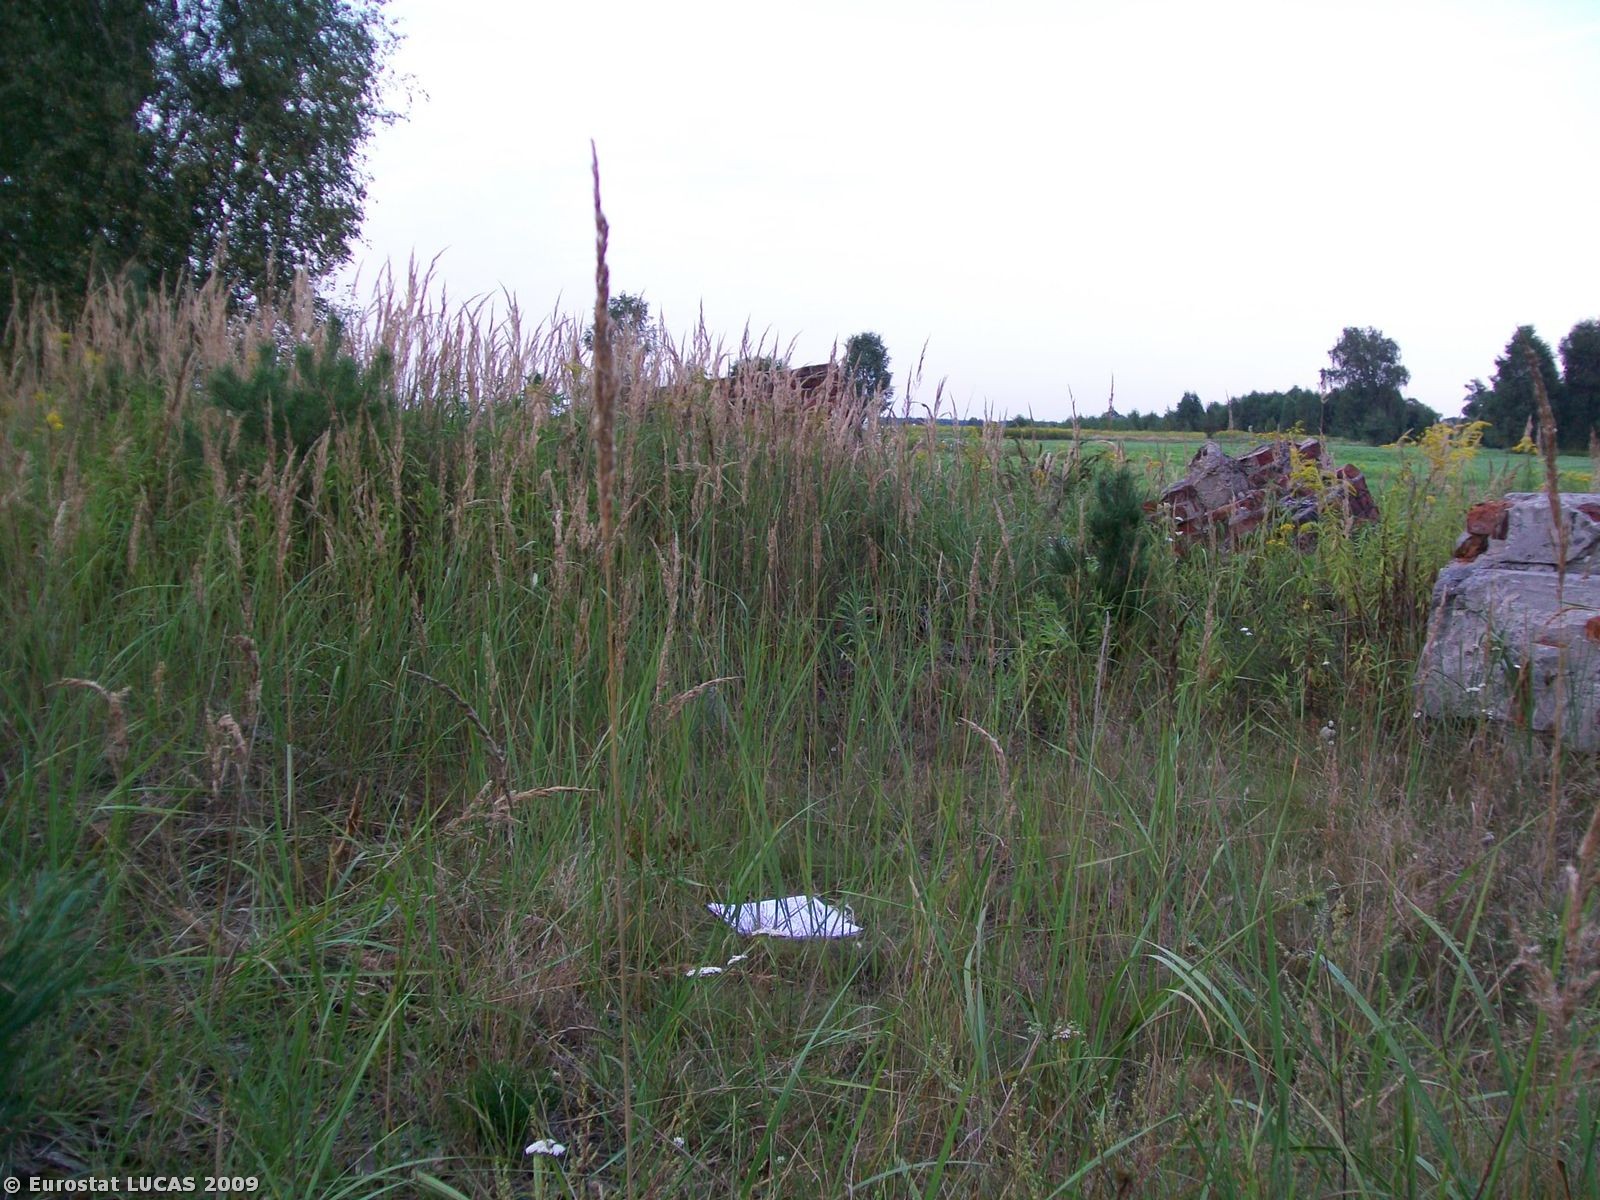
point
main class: Grassland
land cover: Spontaneously vegetated surfaces
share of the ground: > 75 %
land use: Unused
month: August
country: PL
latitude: 50.9388
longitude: 17.9135
